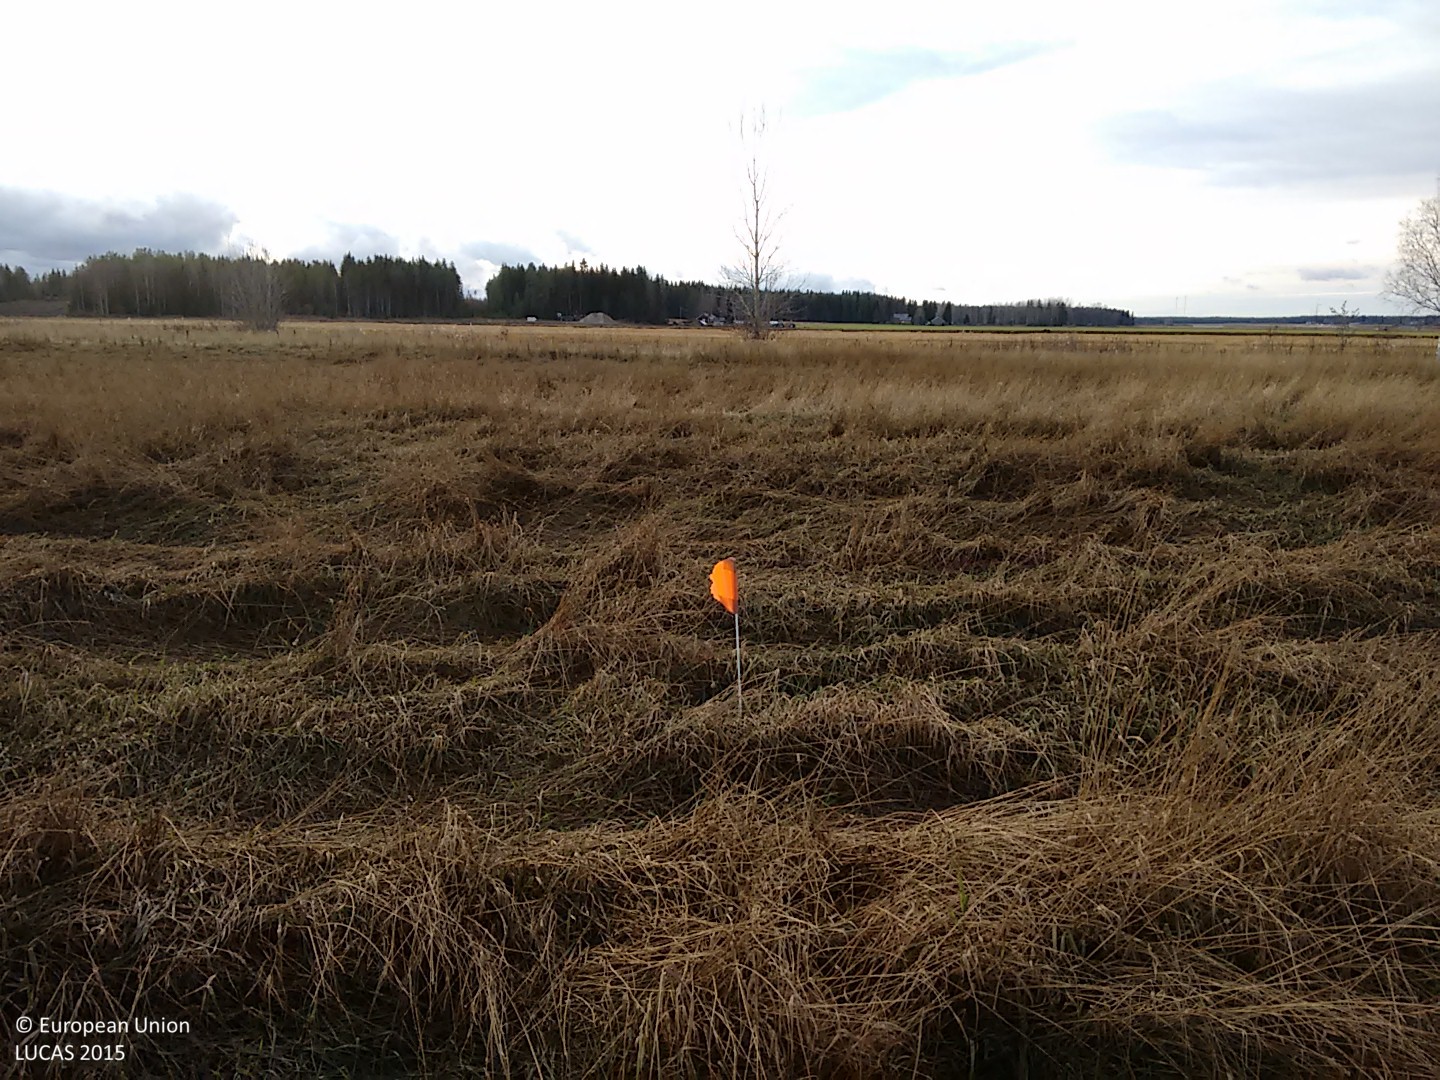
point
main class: Cropland
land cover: Temporary grasslands
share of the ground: > 75 %
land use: Agriculture (excluding fallow land and kitchen gardens)
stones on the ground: < 10 %
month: October
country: FI
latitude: 63.9478
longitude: 25.0869
